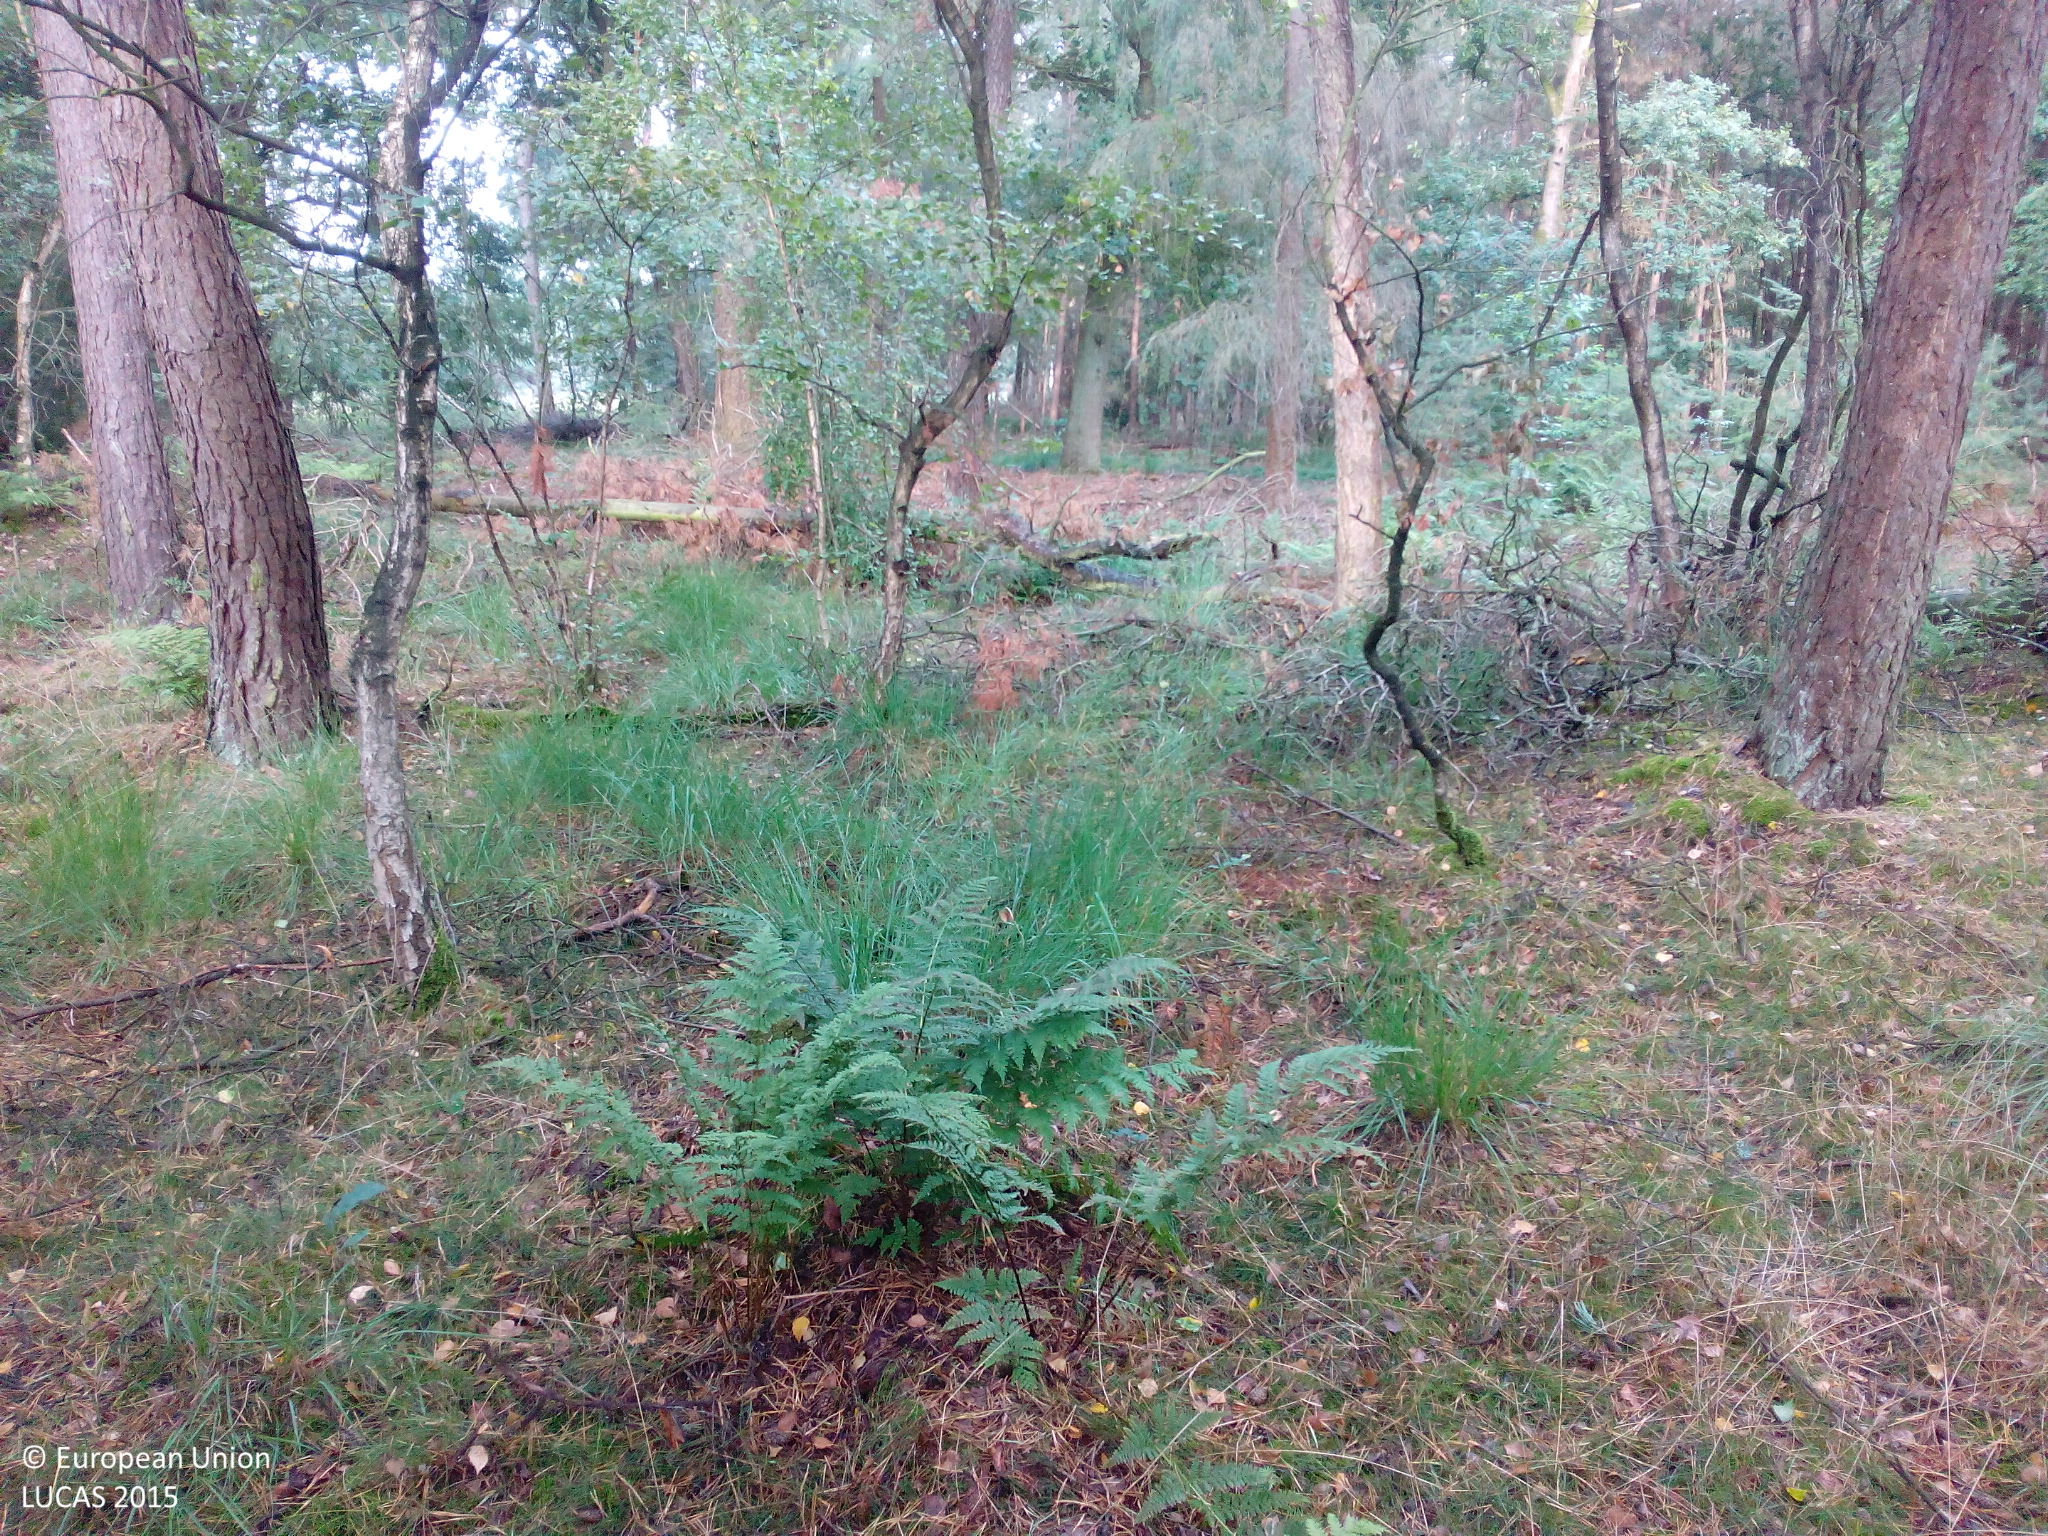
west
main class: Woodland
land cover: Pine dominated mixed woodland
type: hemiboreal forest and nemoral coniferous forest and mixed broadleaved-coniferous forest
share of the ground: > 75 %
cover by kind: coniferous forest trees 65 %, broadleaved forest trees 35 %
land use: Forestry
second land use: Amenities, museums, leisure
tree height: > 5 m
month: August
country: NL
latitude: 51.5545
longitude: 5.5127
